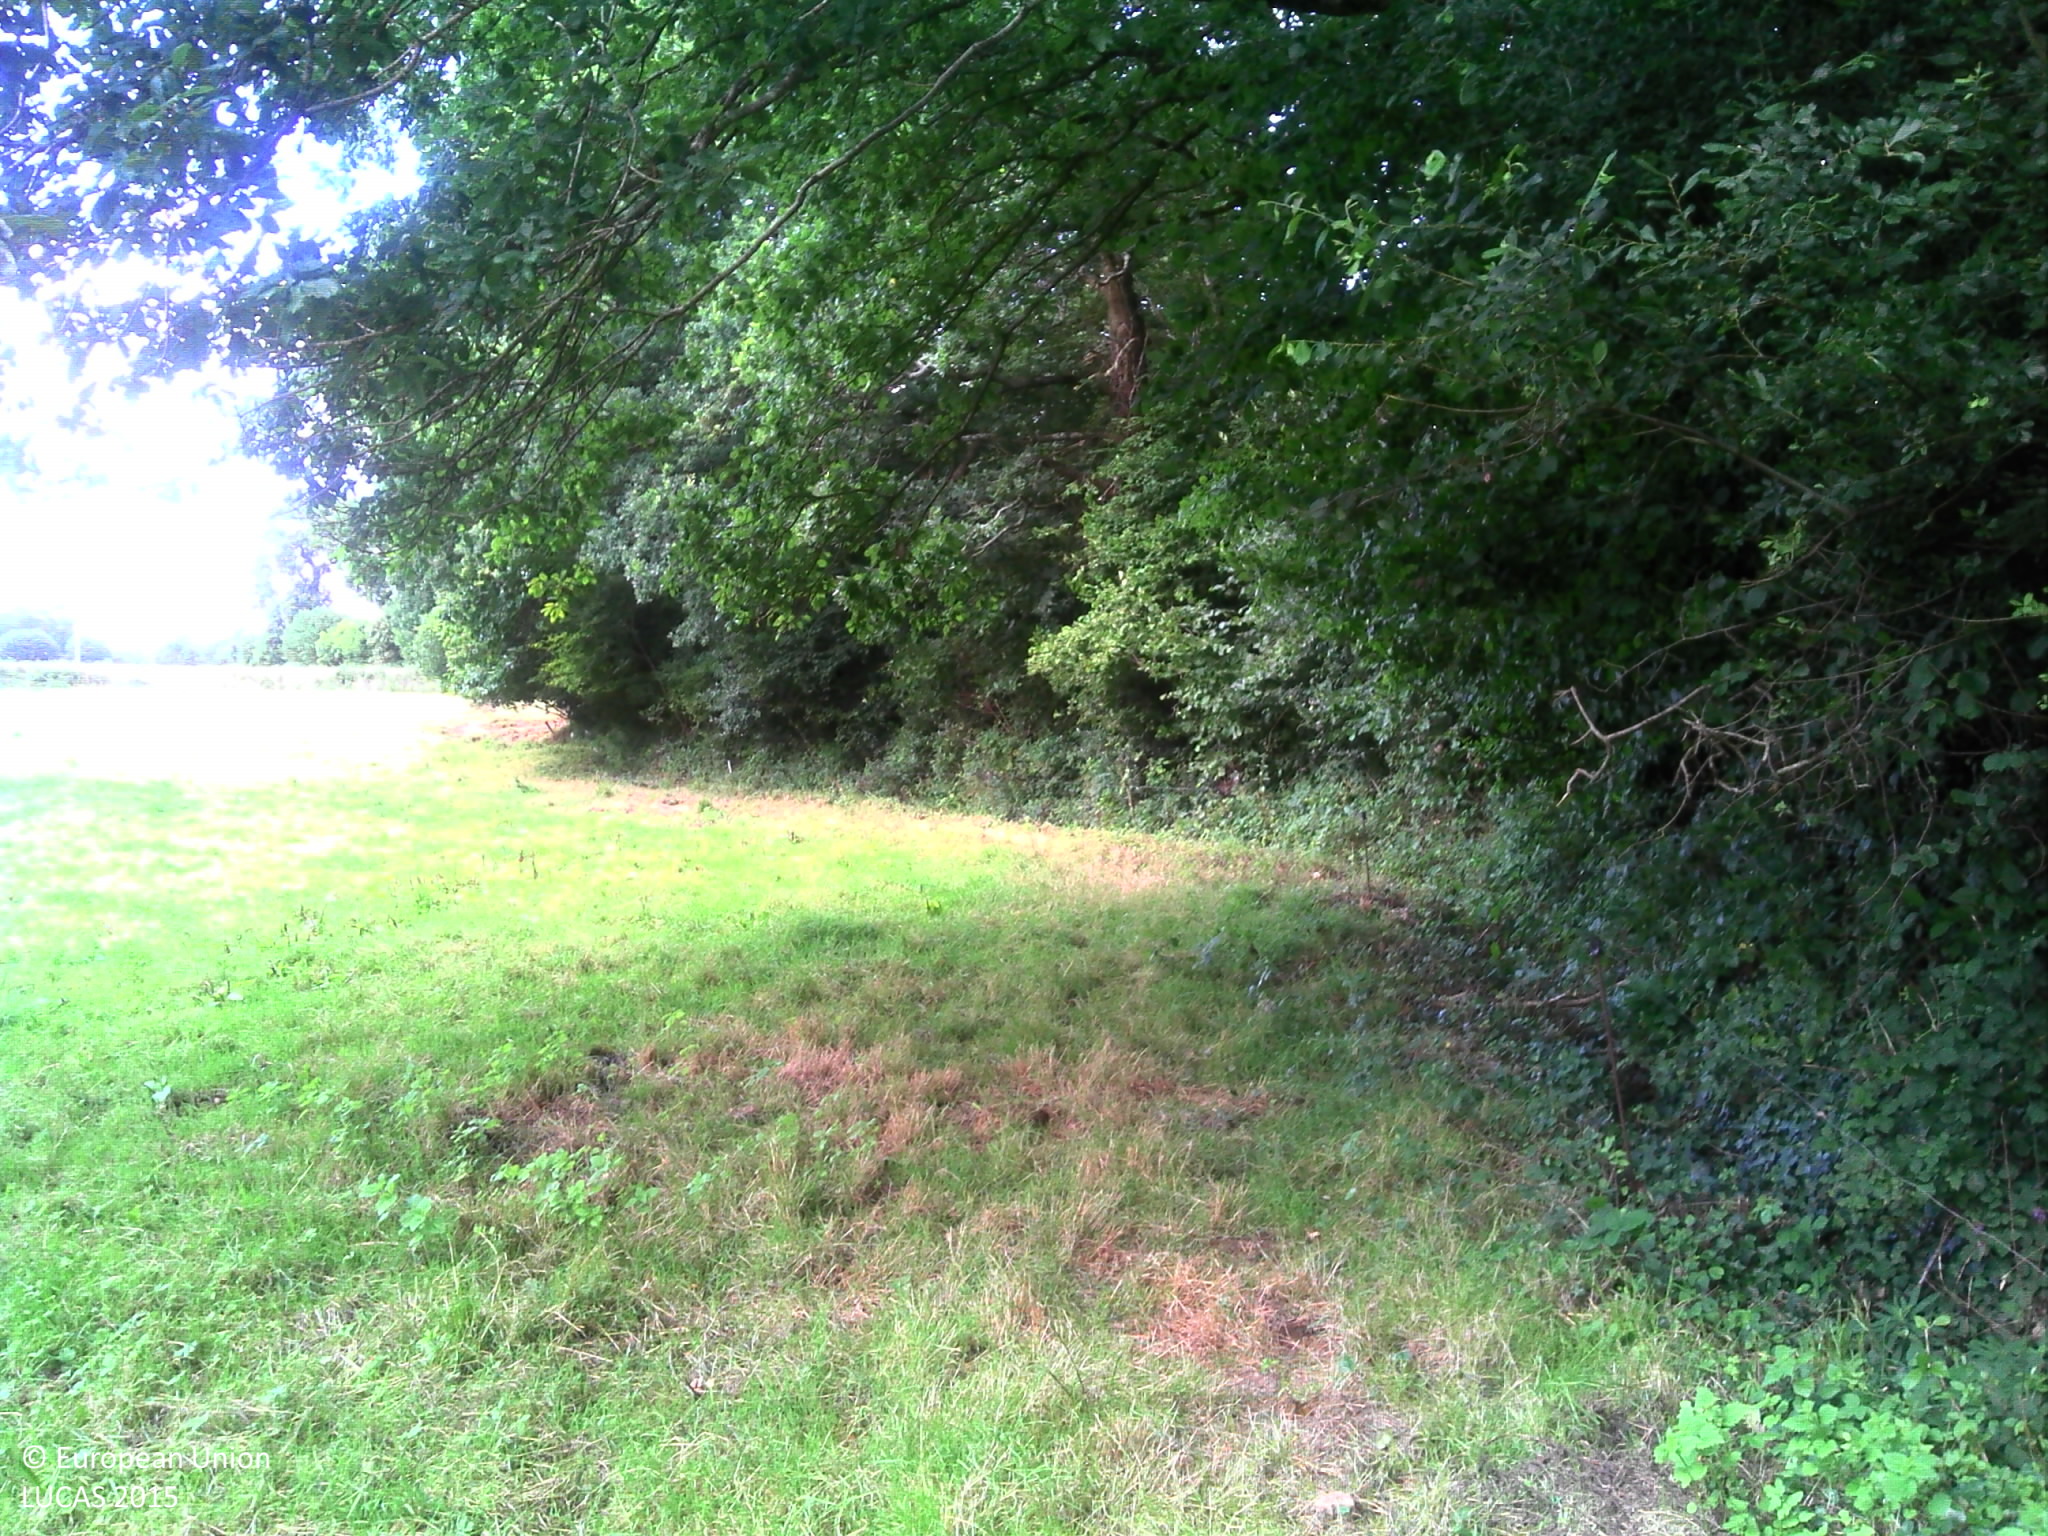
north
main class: Grassland
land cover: Grassland without tree/shrub cover
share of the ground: > 75 %
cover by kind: herbaceous plants 100 %
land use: Agriculture (excluding fallow land and kitchen gardens)
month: July
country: FR
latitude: 48.5087
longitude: -3.4379
